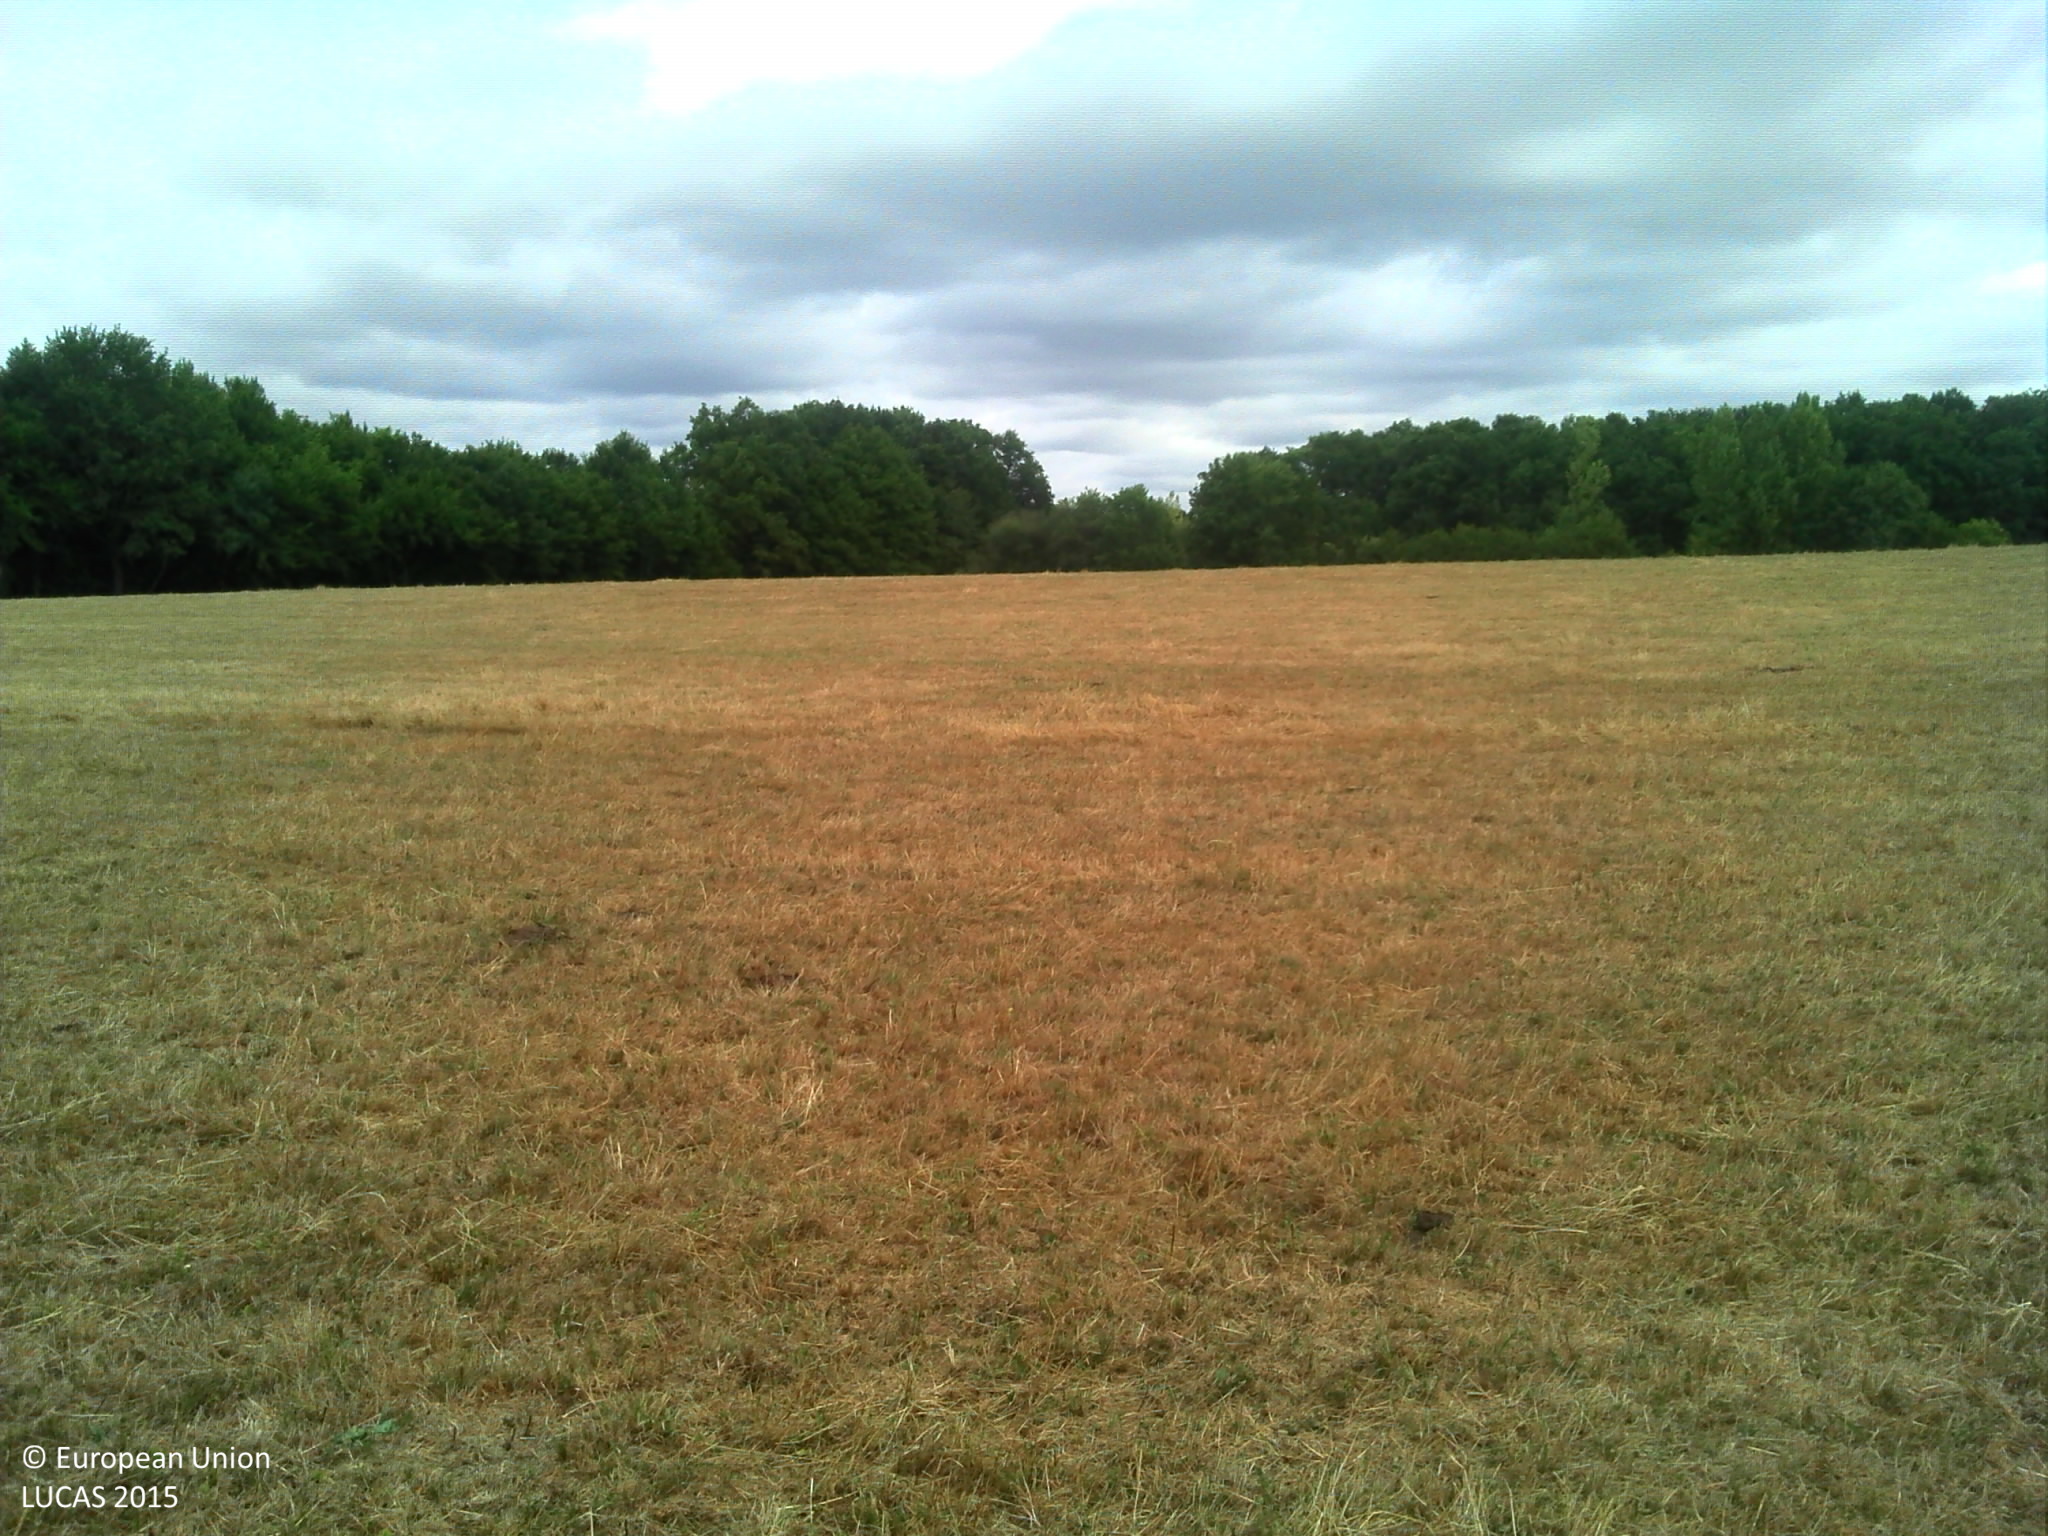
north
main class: Grassland
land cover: Grassland without tree/shrub cover
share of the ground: > 75 %
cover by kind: herbaceous plants 95 %
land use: Agriculture (excluding fallow land and kitchen gardens)
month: July
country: FR
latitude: 45.4736
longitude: 1.3328
